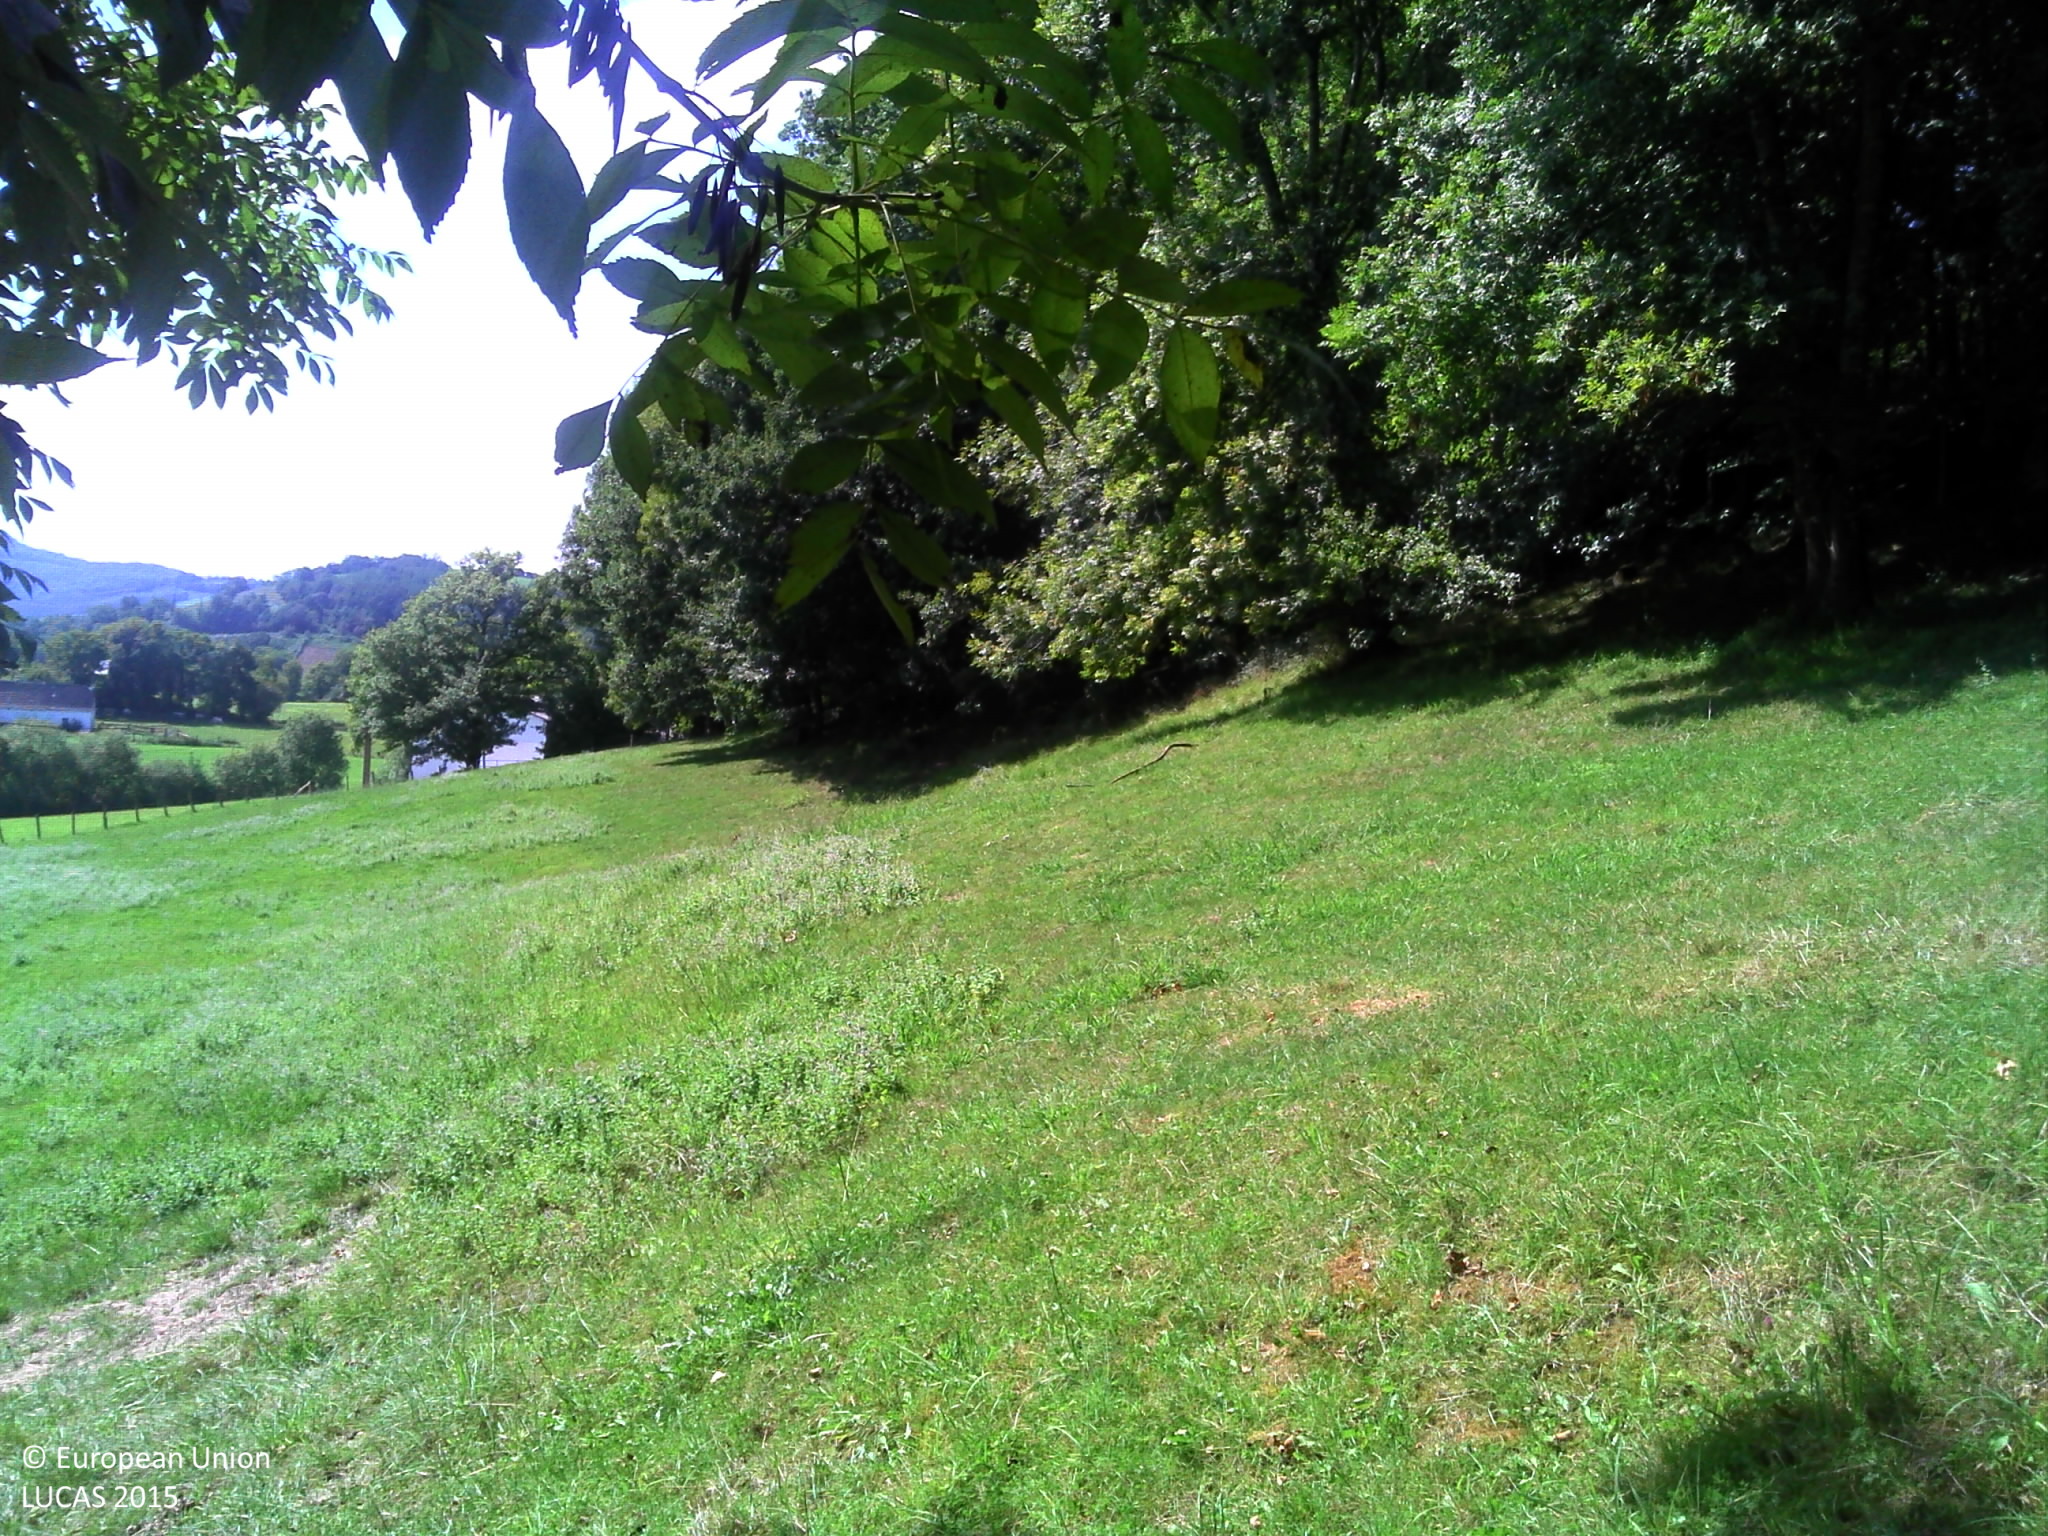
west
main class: Grassland
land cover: Grassland without tree/shrub cover
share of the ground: > 75 %
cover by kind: herbaceous plants 100 %
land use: Agriculture (excluding fallow land and kitchen gardens)
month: September
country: FR
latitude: 43.1872
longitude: -0.9492
